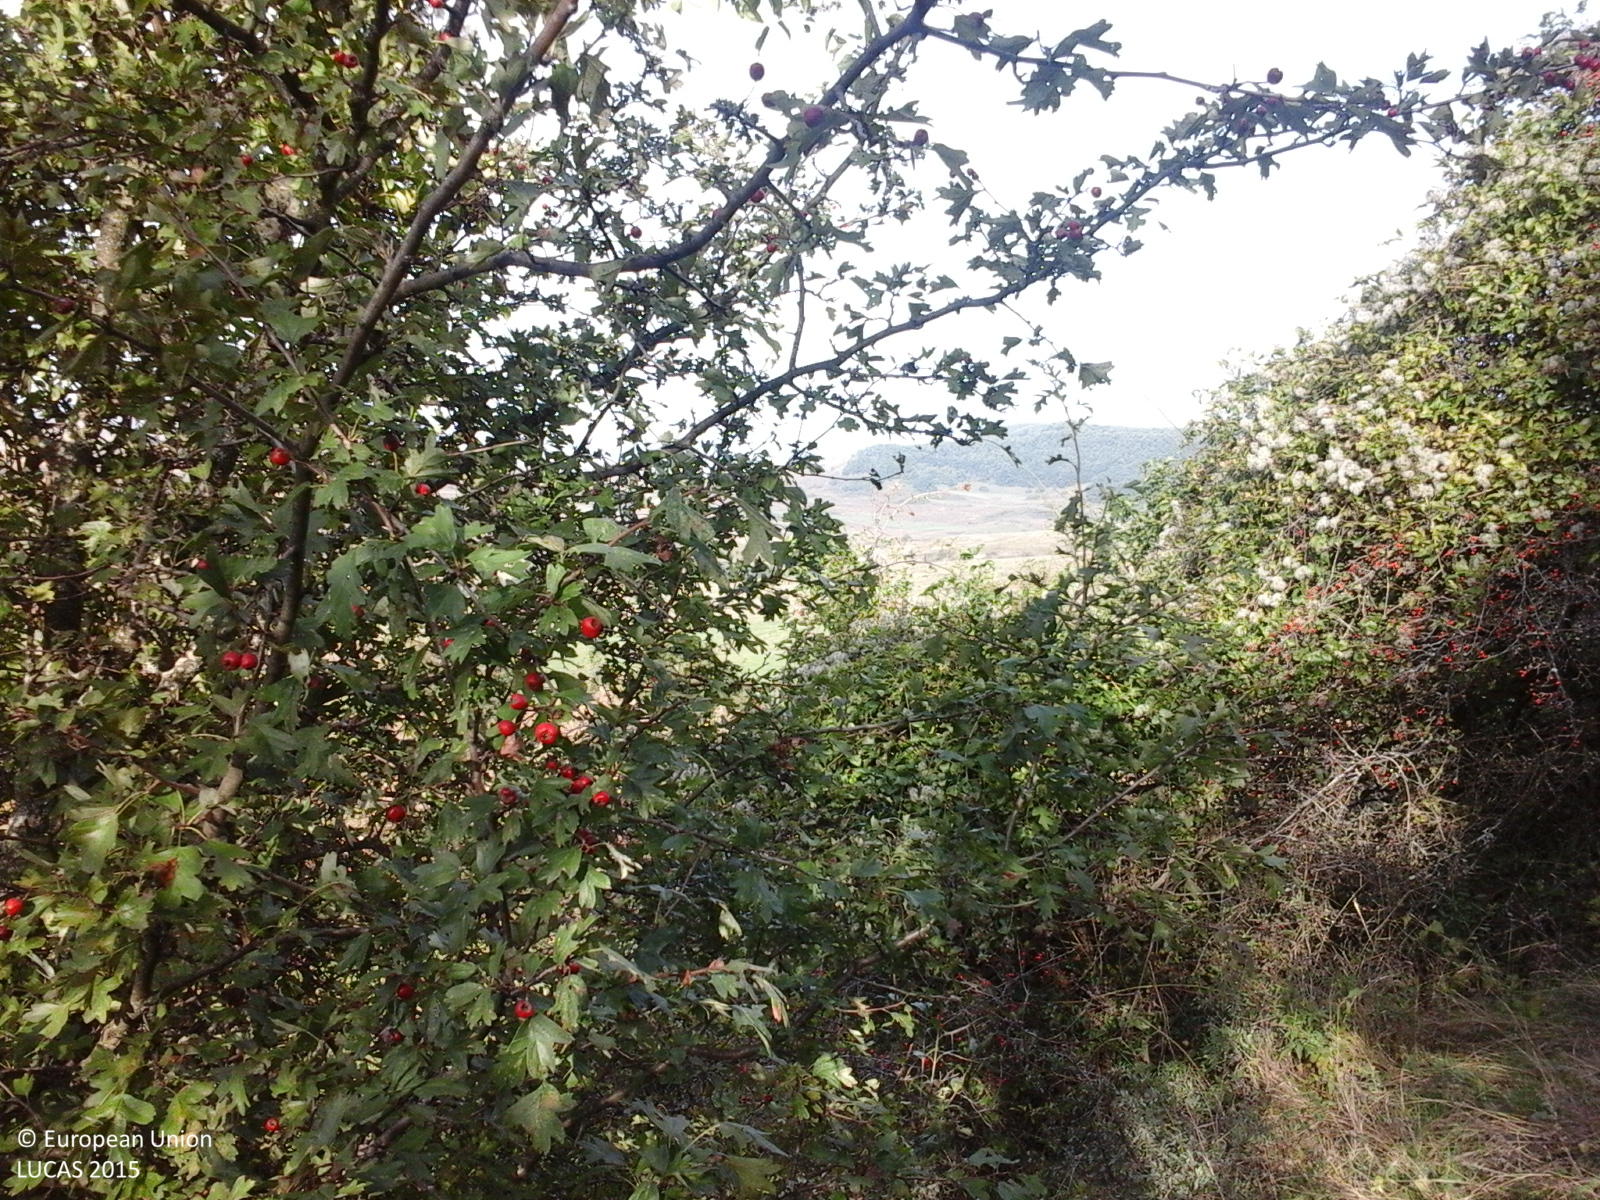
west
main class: Shrubland
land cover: Shrubland with sparse tree cover
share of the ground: > 75 %
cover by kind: herbaceous plants 85 %, shrubs 10 %, broadleaved forest trees 5 %
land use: Agriculture (excluding fallow land and kitchen gardens)
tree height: > 5 m
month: September
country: RO
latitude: 46.8593
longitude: 23.3547
